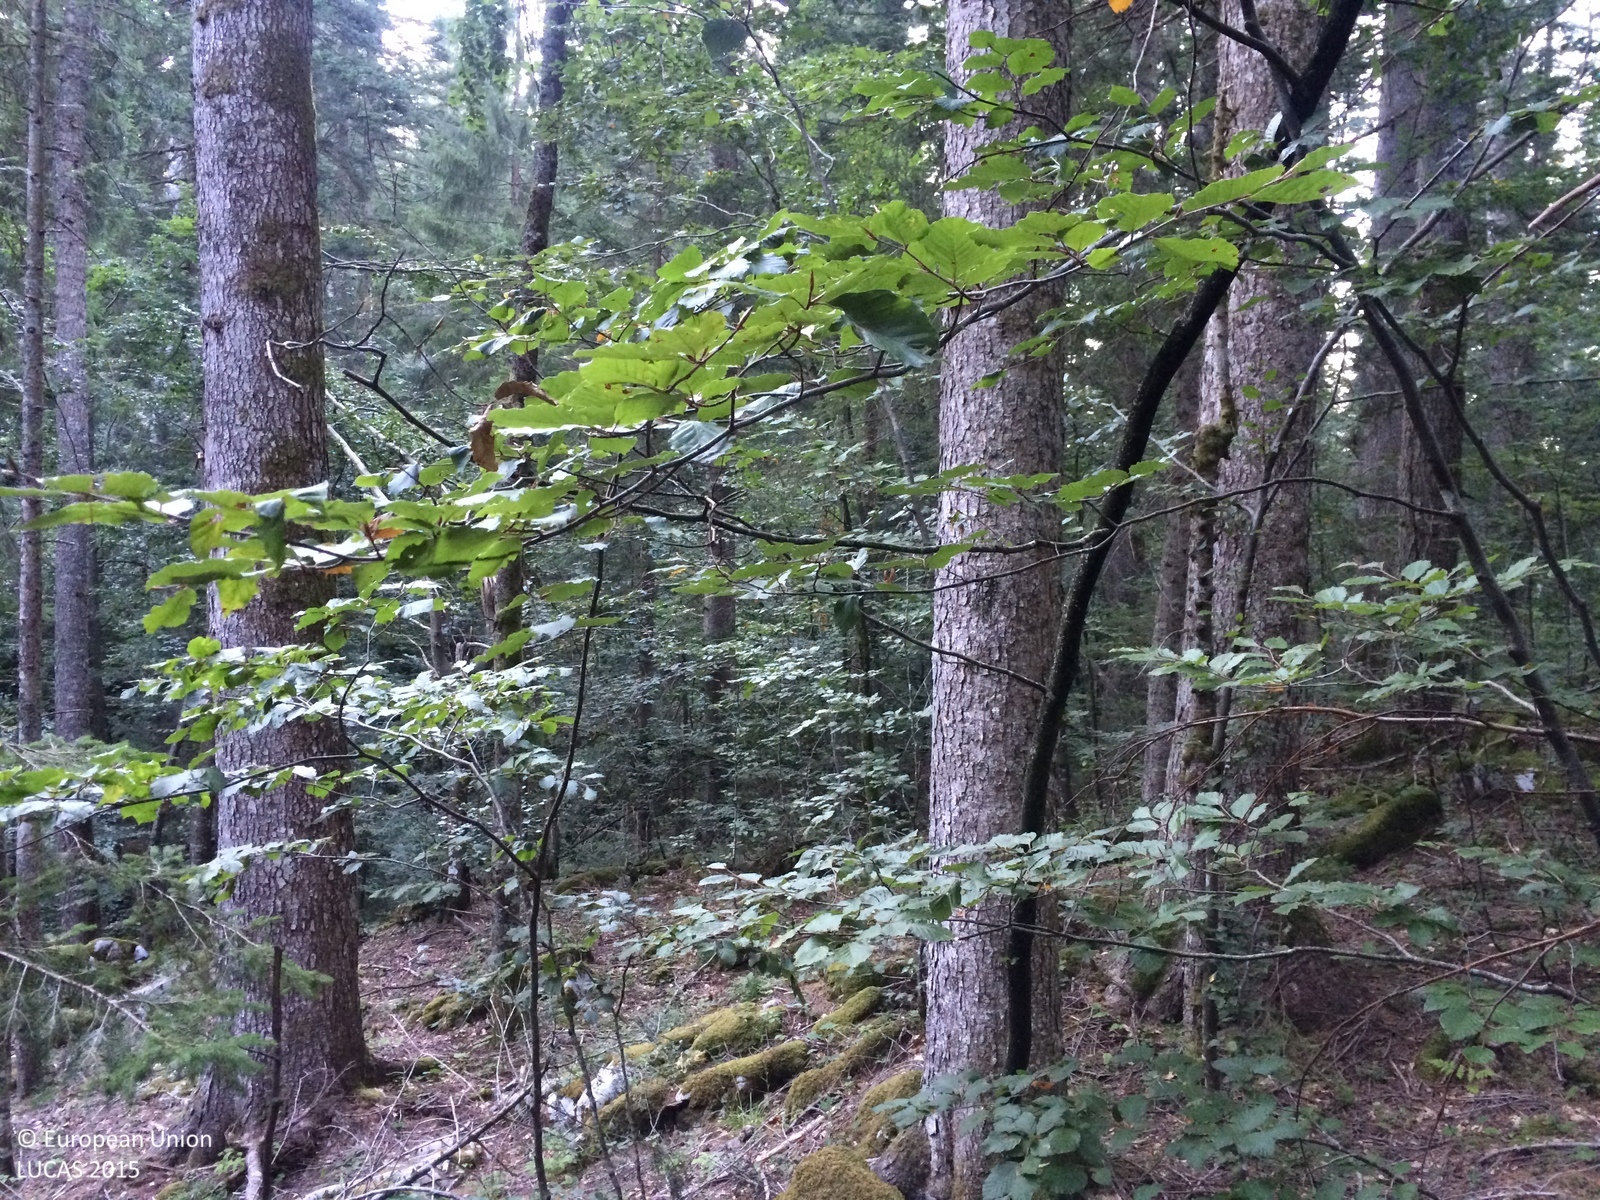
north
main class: Woodland
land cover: Other mixed woodland
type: mountainous beech forest
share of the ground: > 75 %
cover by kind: broadleaved forest trees 75 %, coniferous forest trees 25 %
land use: Forestry
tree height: > 5 m
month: September
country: HR
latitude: 45.5668
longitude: 14.5953
